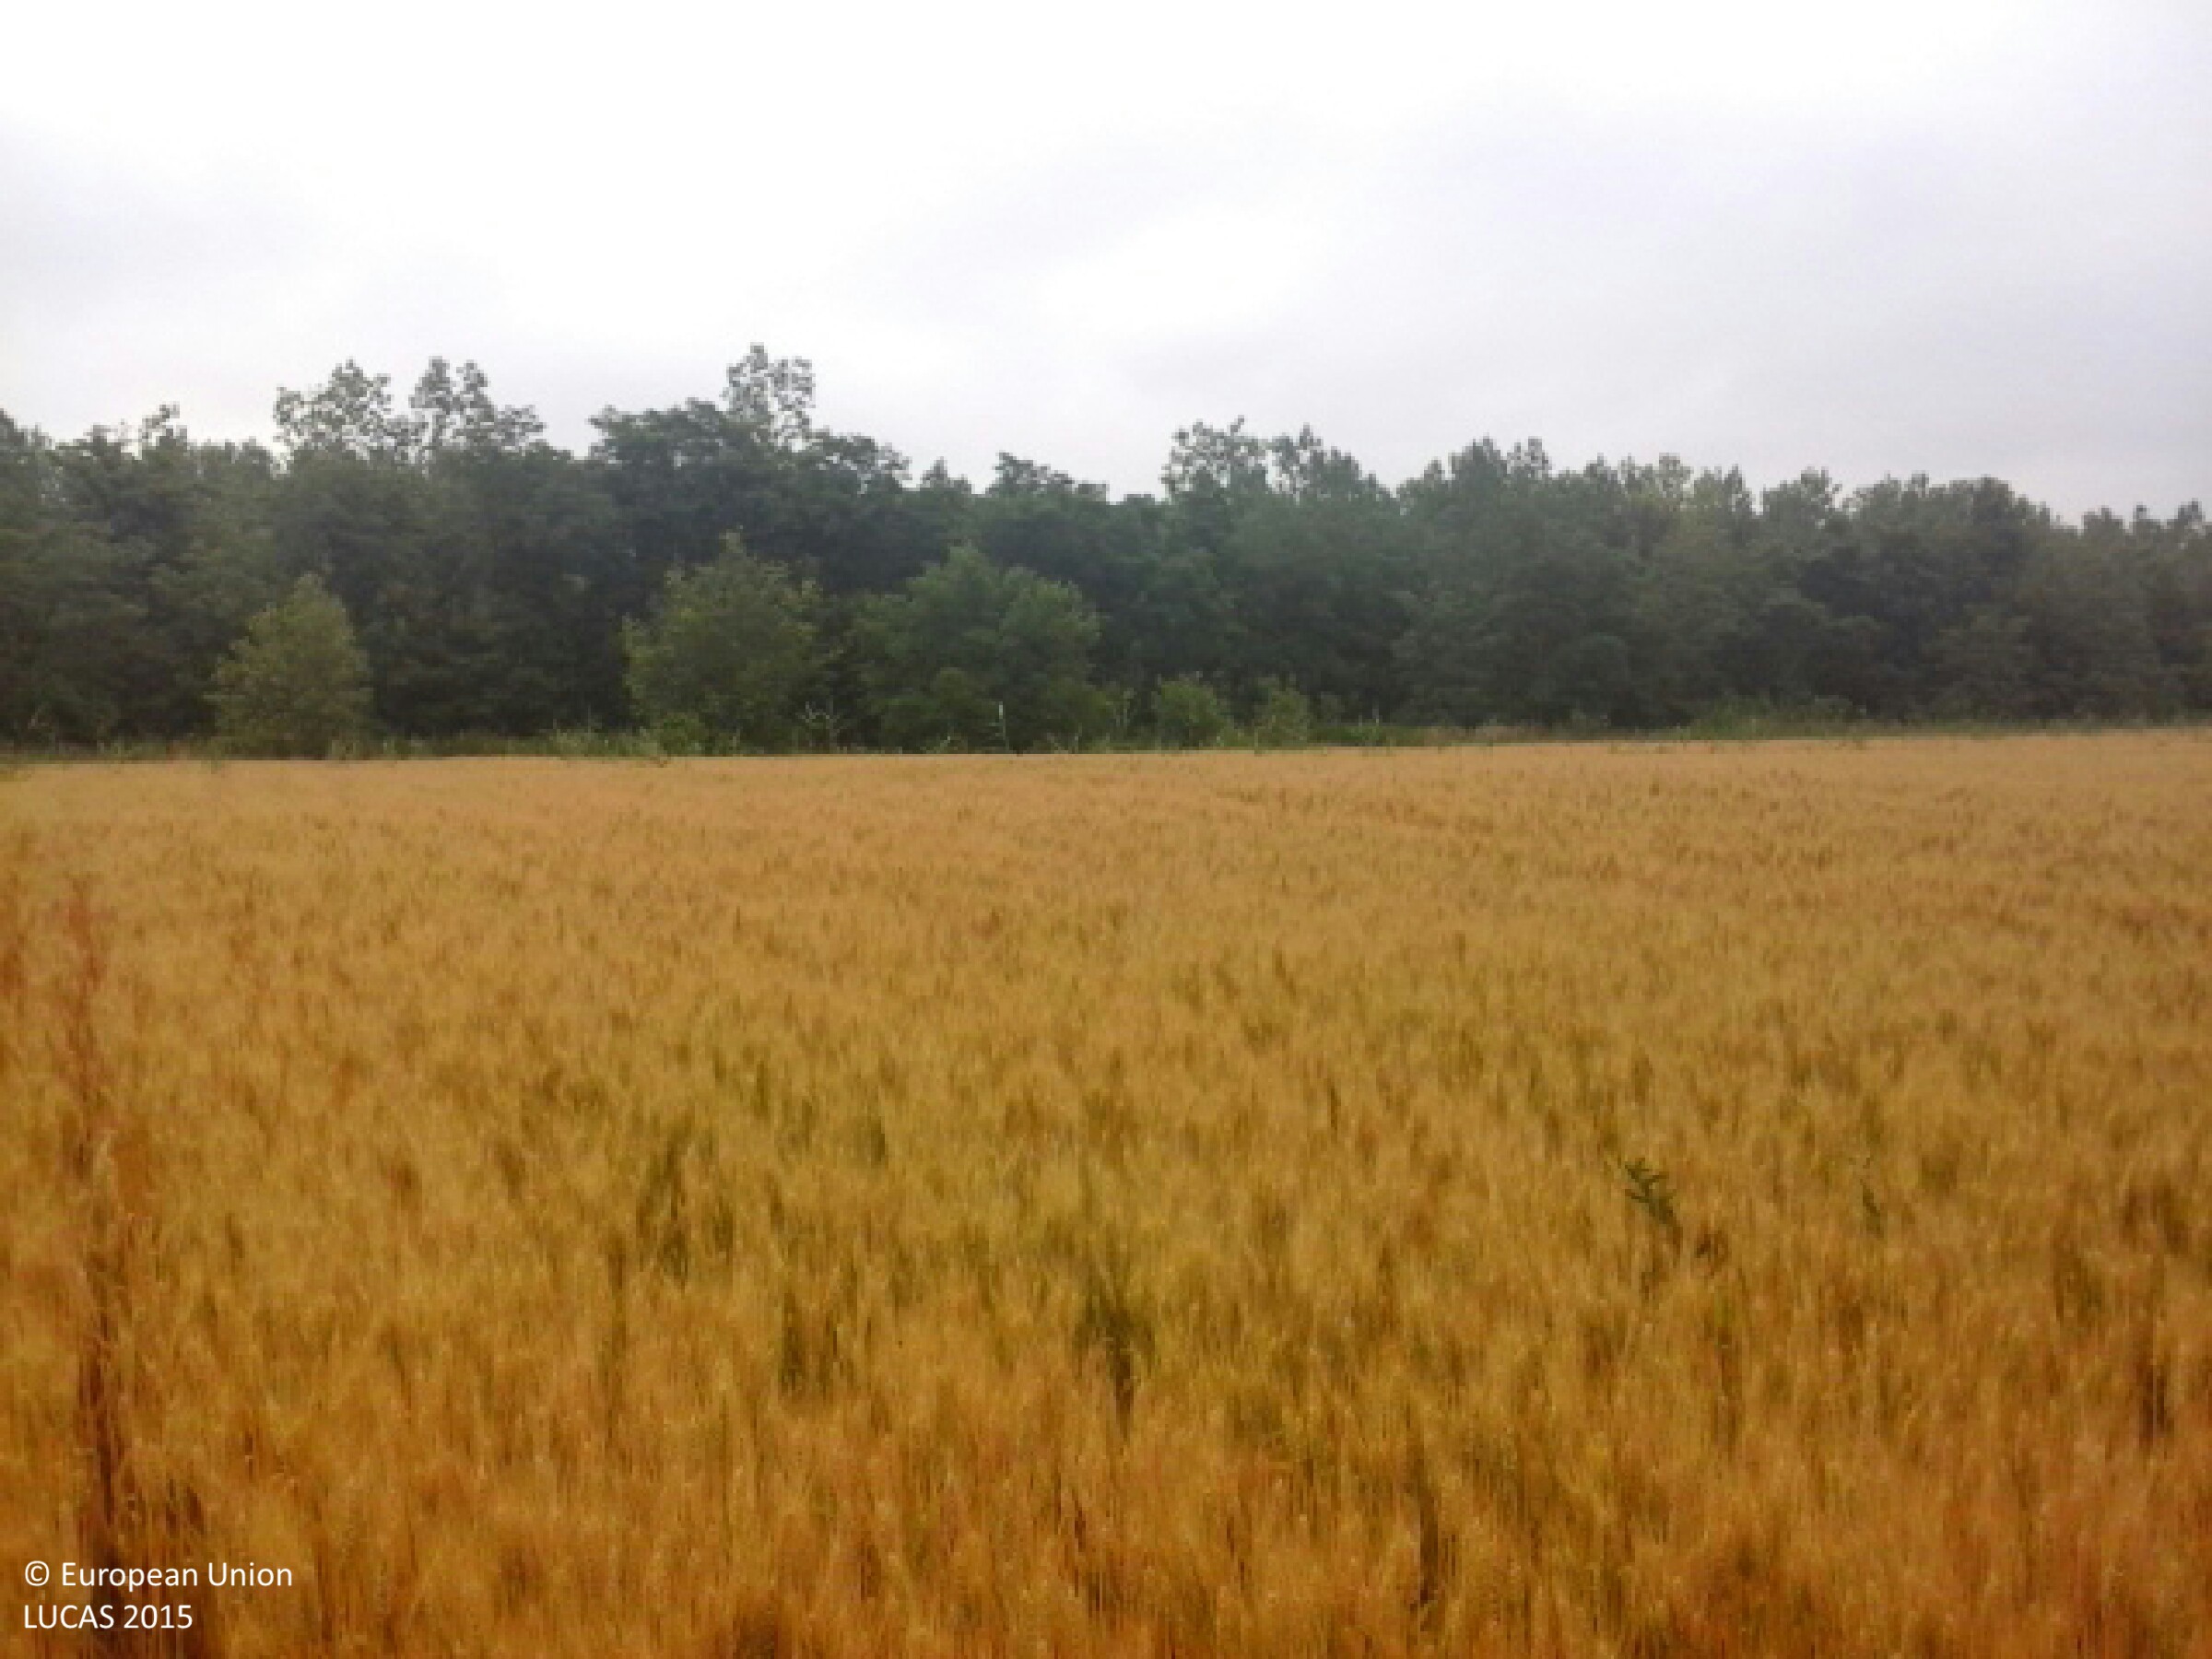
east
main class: Cropland
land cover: Triticale
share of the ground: > 75 %
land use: Agriculture (excluding fallow land and kitchen gardens)
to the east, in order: Triticale; Abandoned hedges; Tracks; Ditches and canals; Broadleaved woodland; Grassland without tree/shrub cover; Broadleaved woodland; Grassland without tree/shrub cover
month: June
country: HU
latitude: 48.0994
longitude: 21.7722
